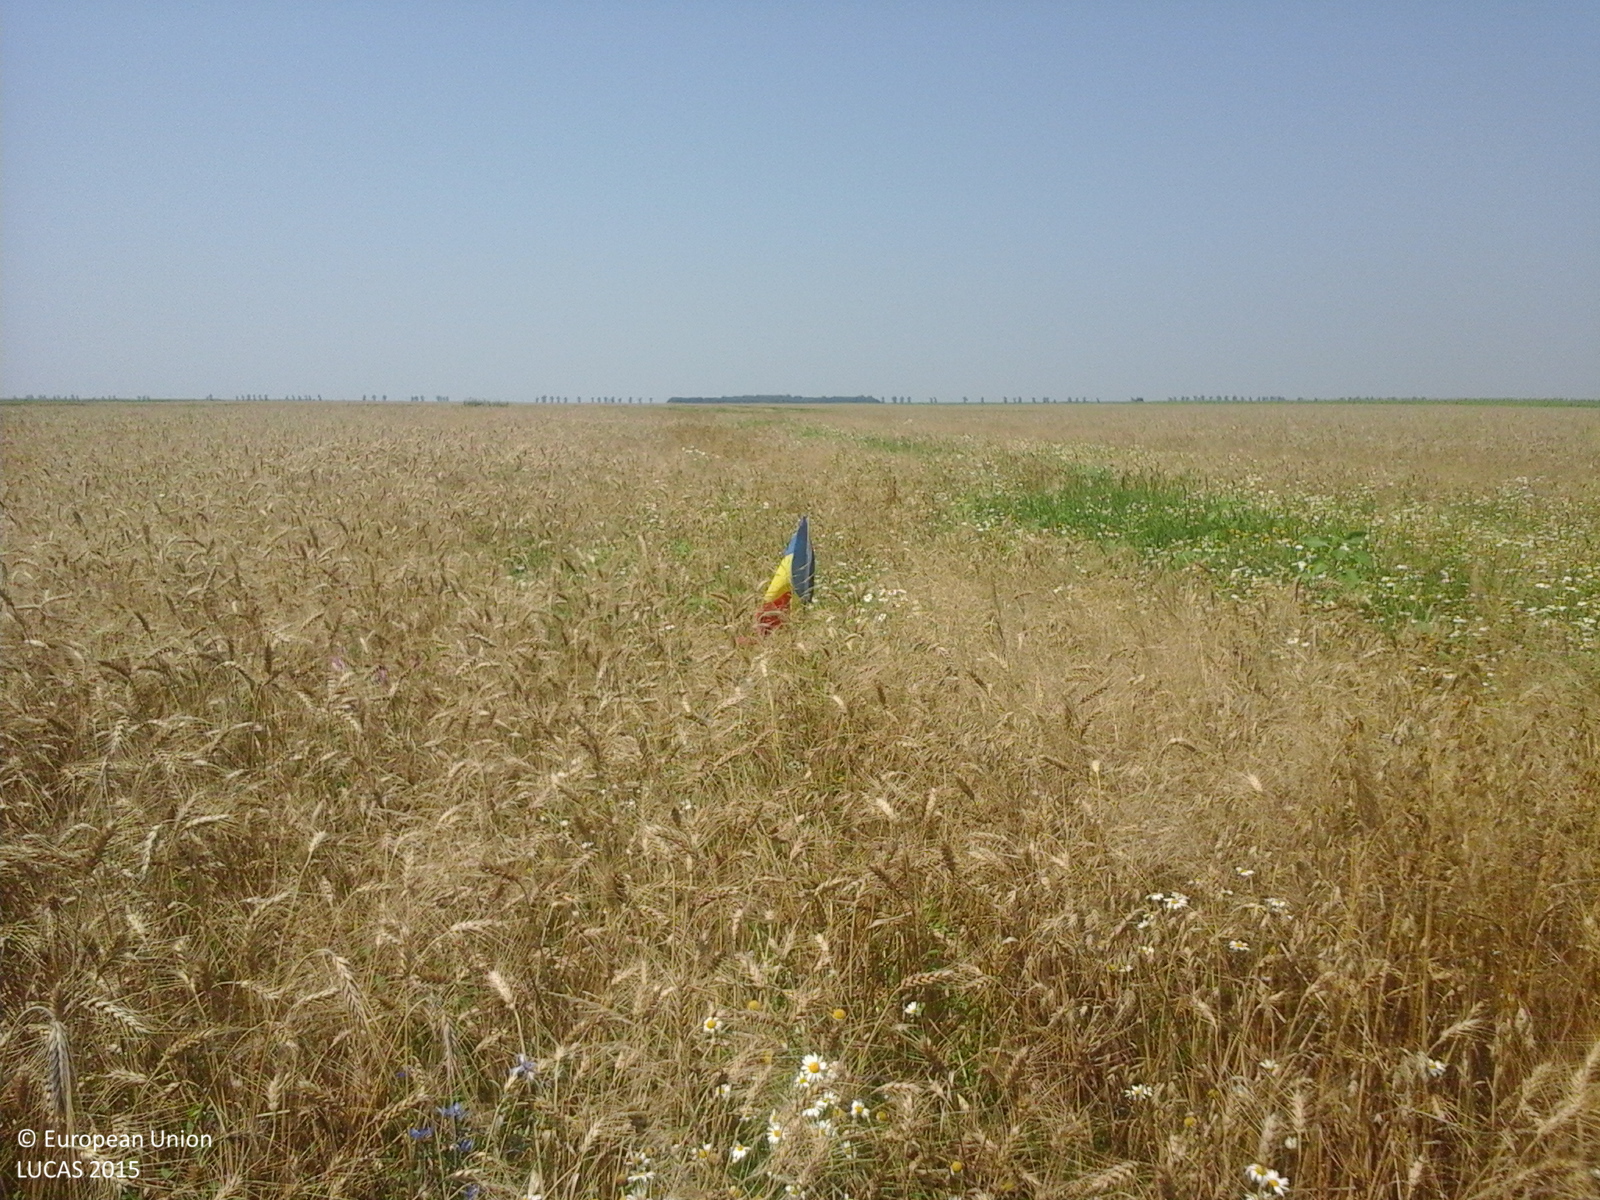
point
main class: Cropland
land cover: Common wheat
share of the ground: > 75 %
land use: Agriculture (excluding fallow land and kitchen gardens)
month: July
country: RO
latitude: 44.3210
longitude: 24.9620
